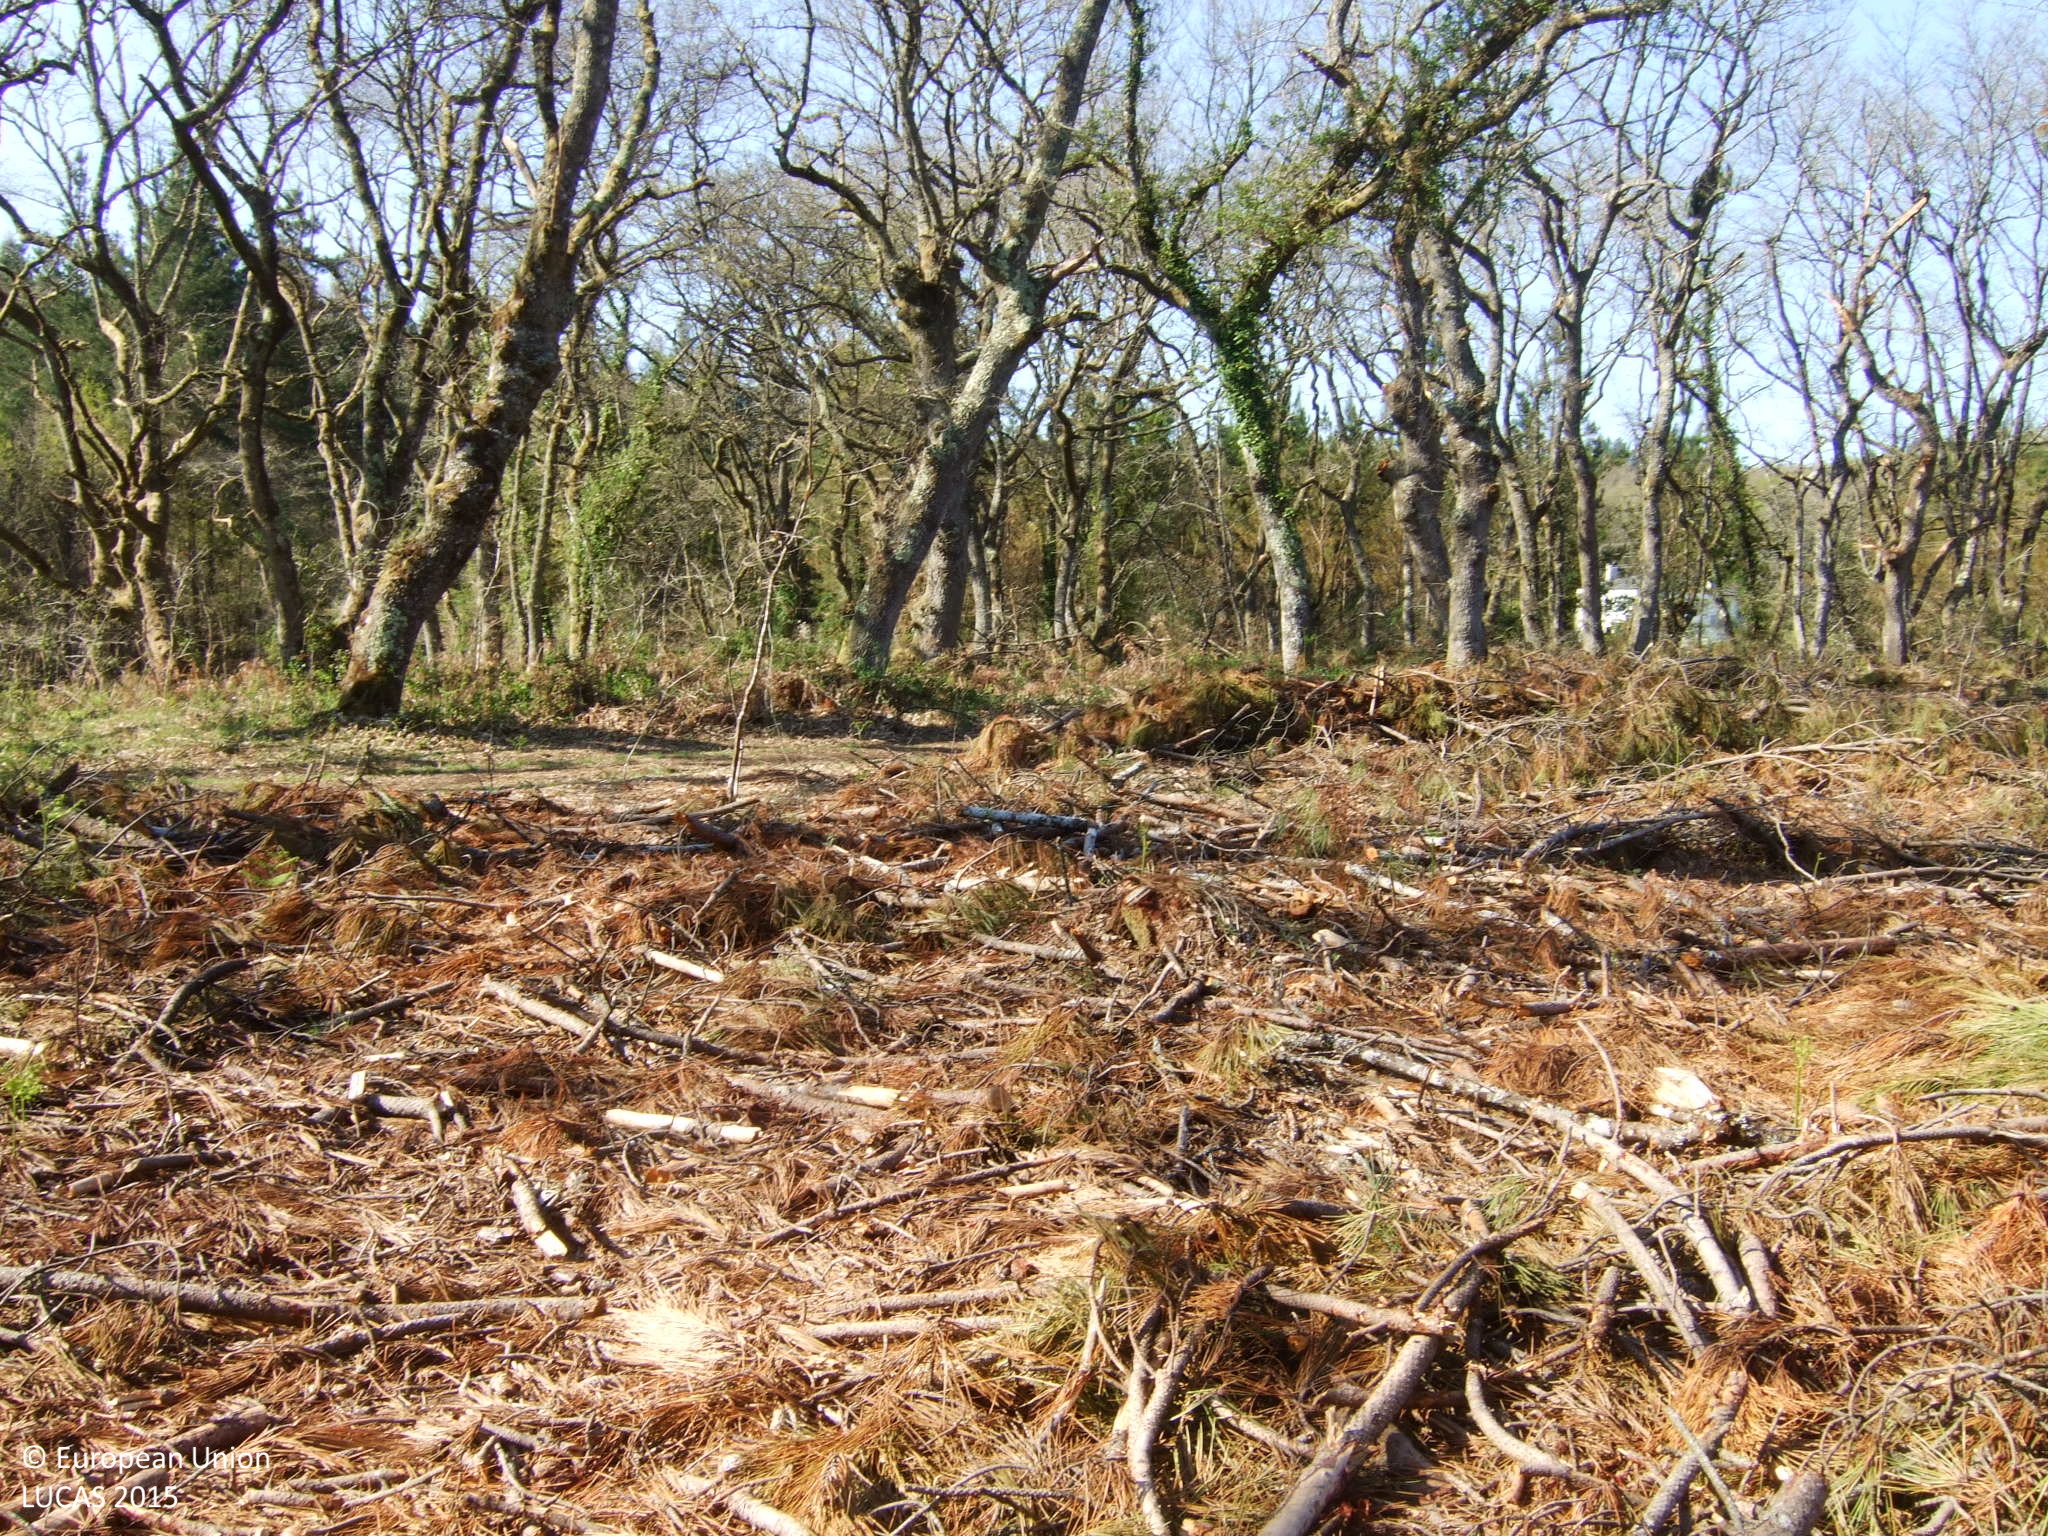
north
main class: Woodland
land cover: Broadleaved woodland
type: acidophilous oak and oak-birch forest
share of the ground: 10 - 25 %
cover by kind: unconsolidated bare surface 85 %, broadleaved forest trees 15 %
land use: Forestry
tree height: > 5 m
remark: Clear cut
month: April
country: ES
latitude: 43.0488
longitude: -7.6226
